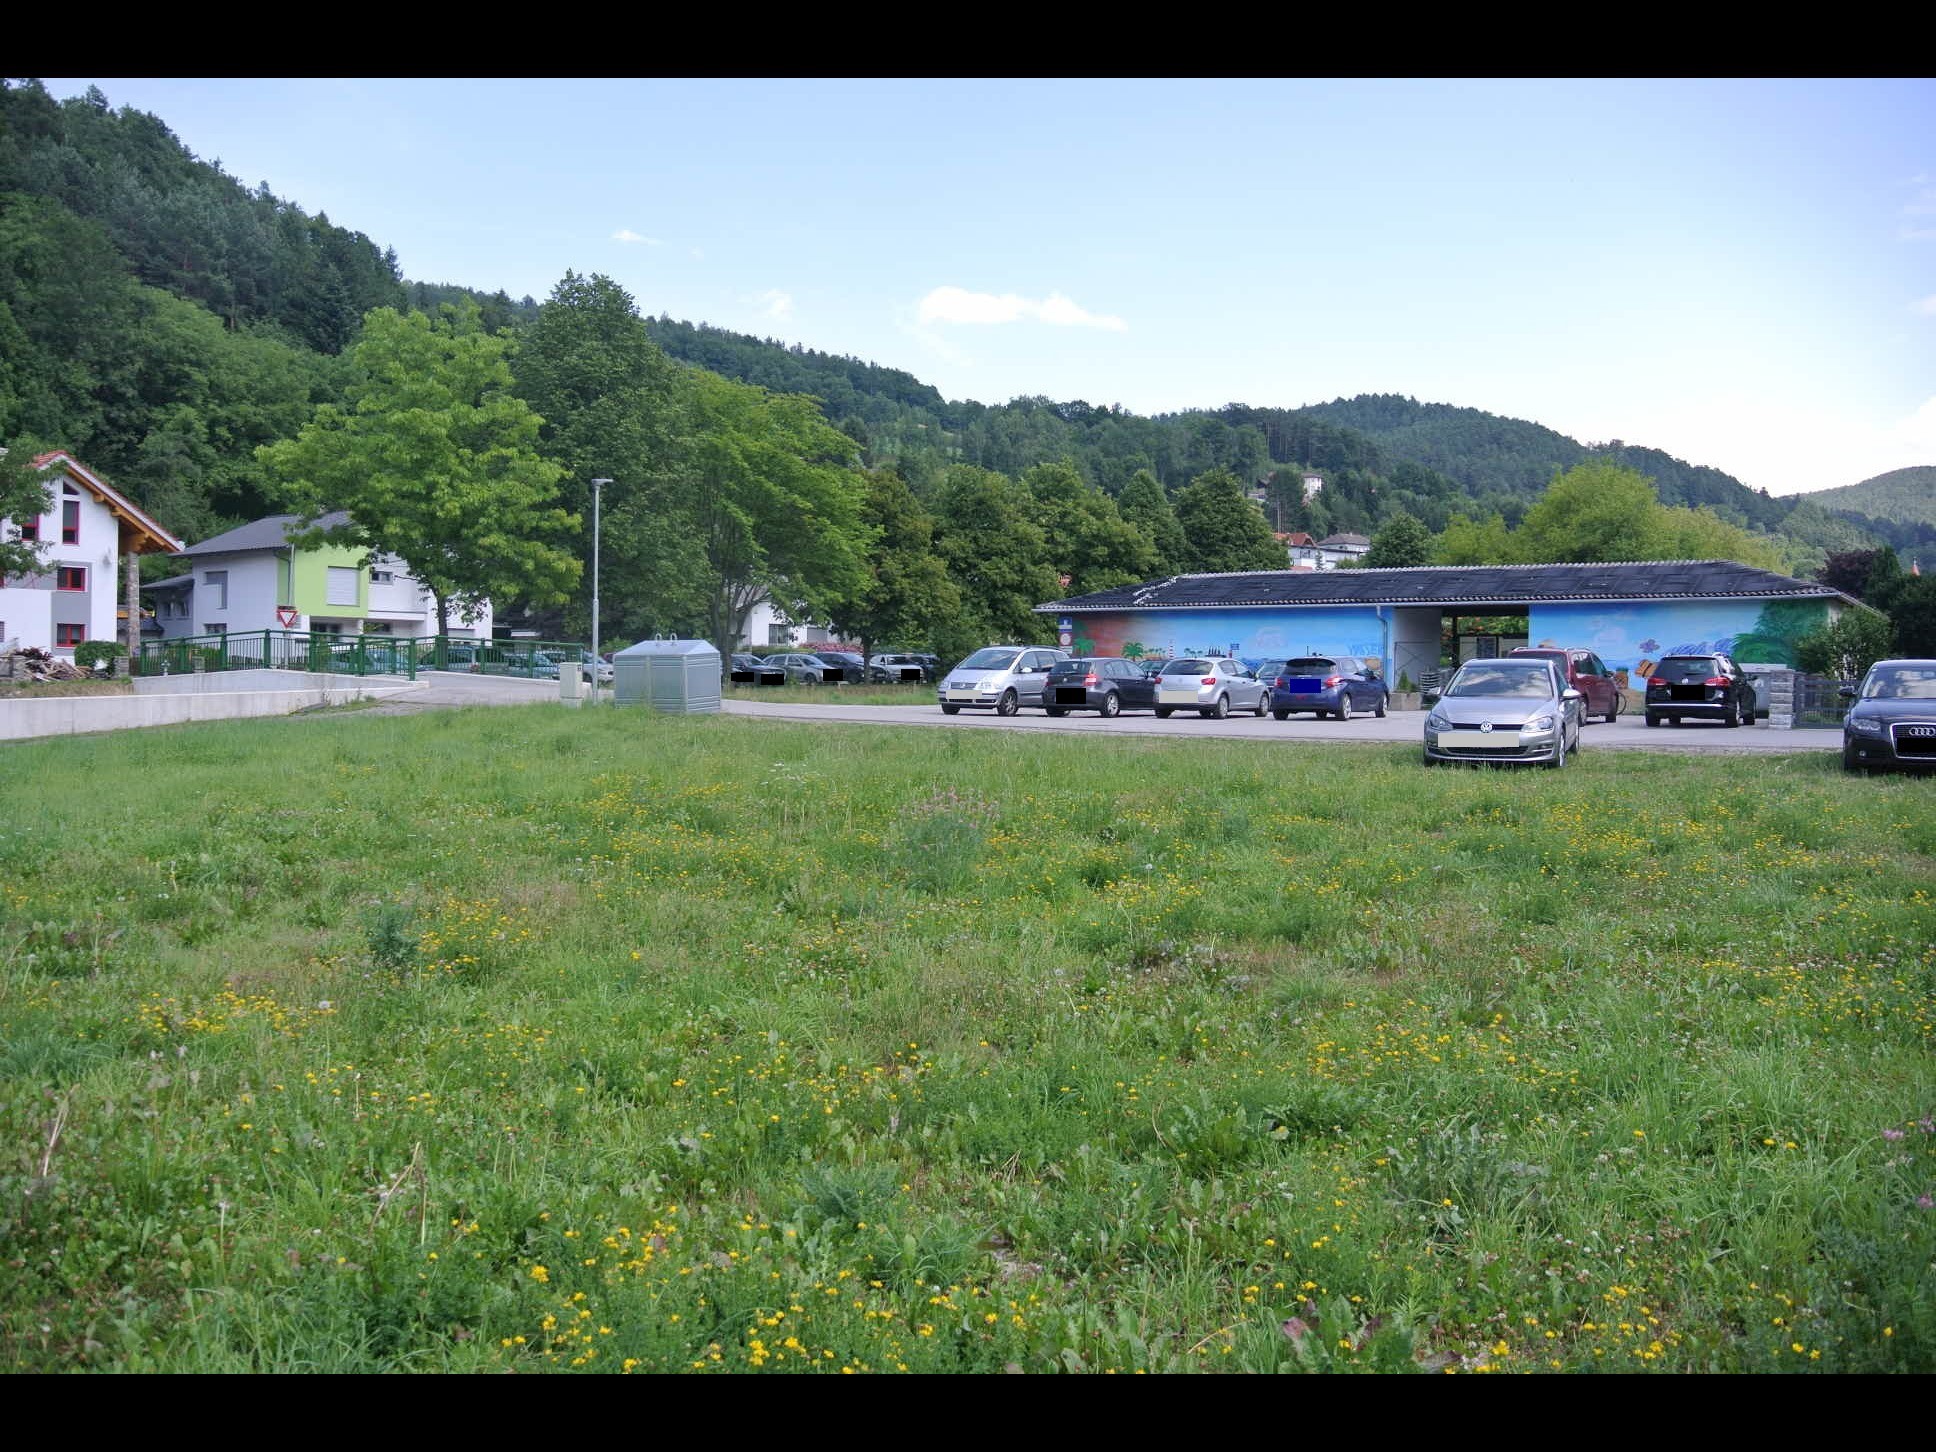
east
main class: Grassland
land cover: Grassland without tree/shrub cover
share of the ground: > 75 %
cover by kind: herbaceous plants 100 %
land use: Abandoned areas
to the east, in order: Grassland without tree/shrub cover; Artificial constructions in urban areas; Rivers and streams; Artificial constructions in urban areas; Broadleaved woodland; Artificial constructions in urban areas; Broadleaved woodland; Fences; Broadleaved woodland; Artificial constructions in urban areas
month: July
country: AT
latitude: 47.6015
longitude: 16.1345
